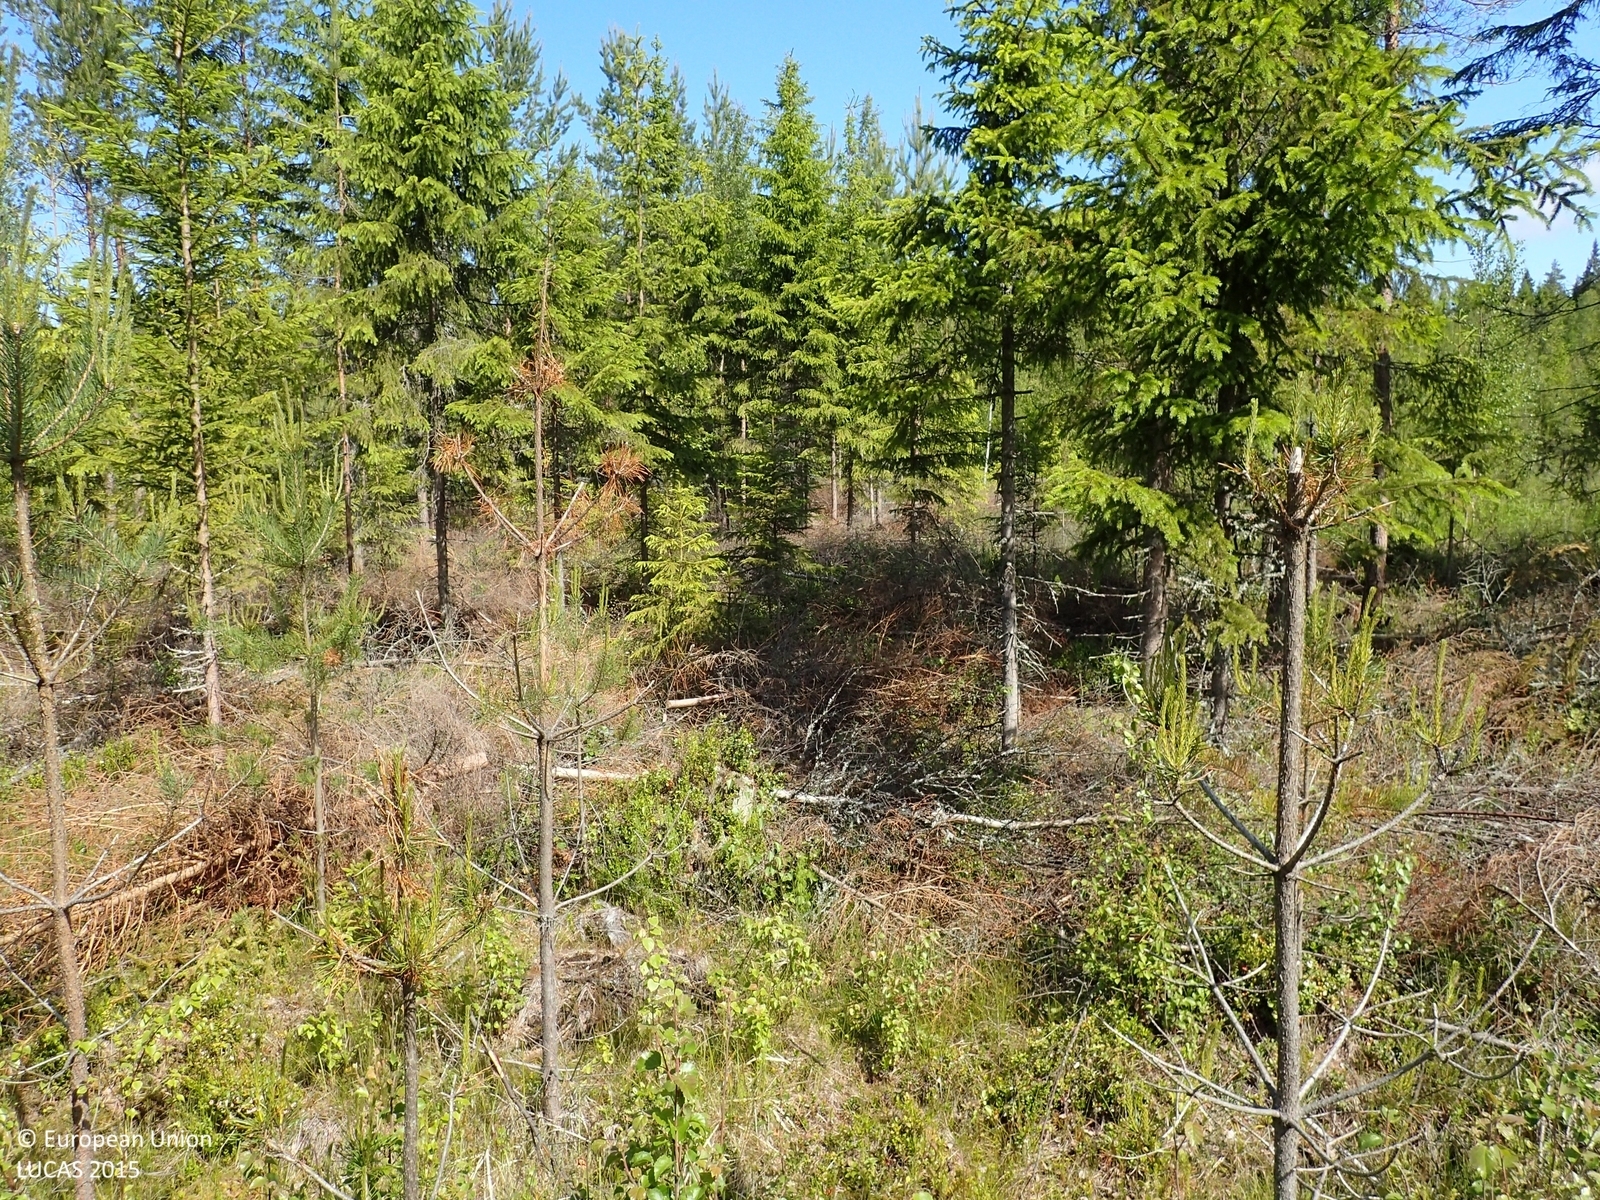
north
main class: Woodland
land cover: Pine dominated mixed woodland
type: boreal forest
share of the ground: 25 - 50 %
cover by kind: herbaceous plants 60 %, coniferous forest trees 15 %, broadleaved forest trees 15 %, shrubs 10 %
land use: Forestry
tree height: < 5 m
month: June
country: FI
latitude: 62.3794
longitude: 21.3924
